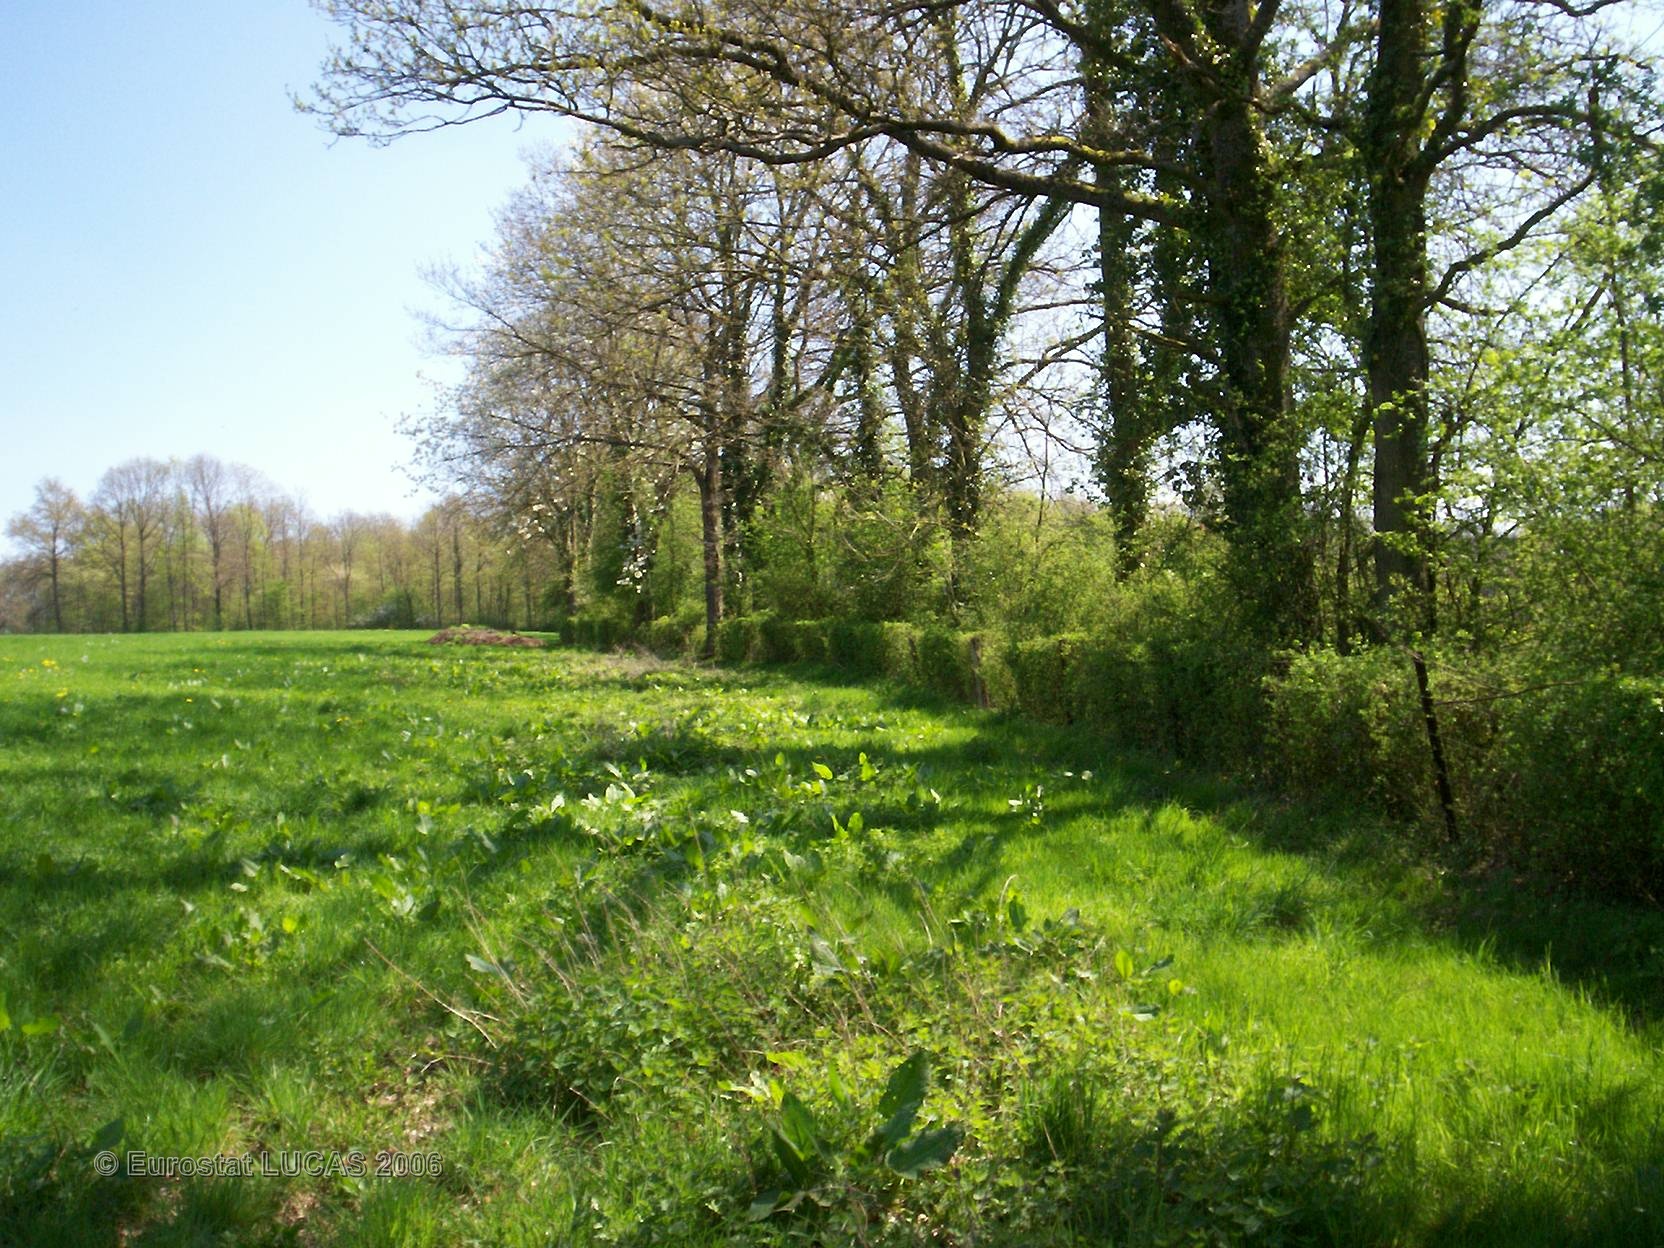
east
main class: Grassland
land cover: Grassland without tree/shrub cover
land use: Agriculture (excluding fallow land and kitchen gardens)
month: April
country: FR
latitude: 49.6673
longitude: 4.3844
